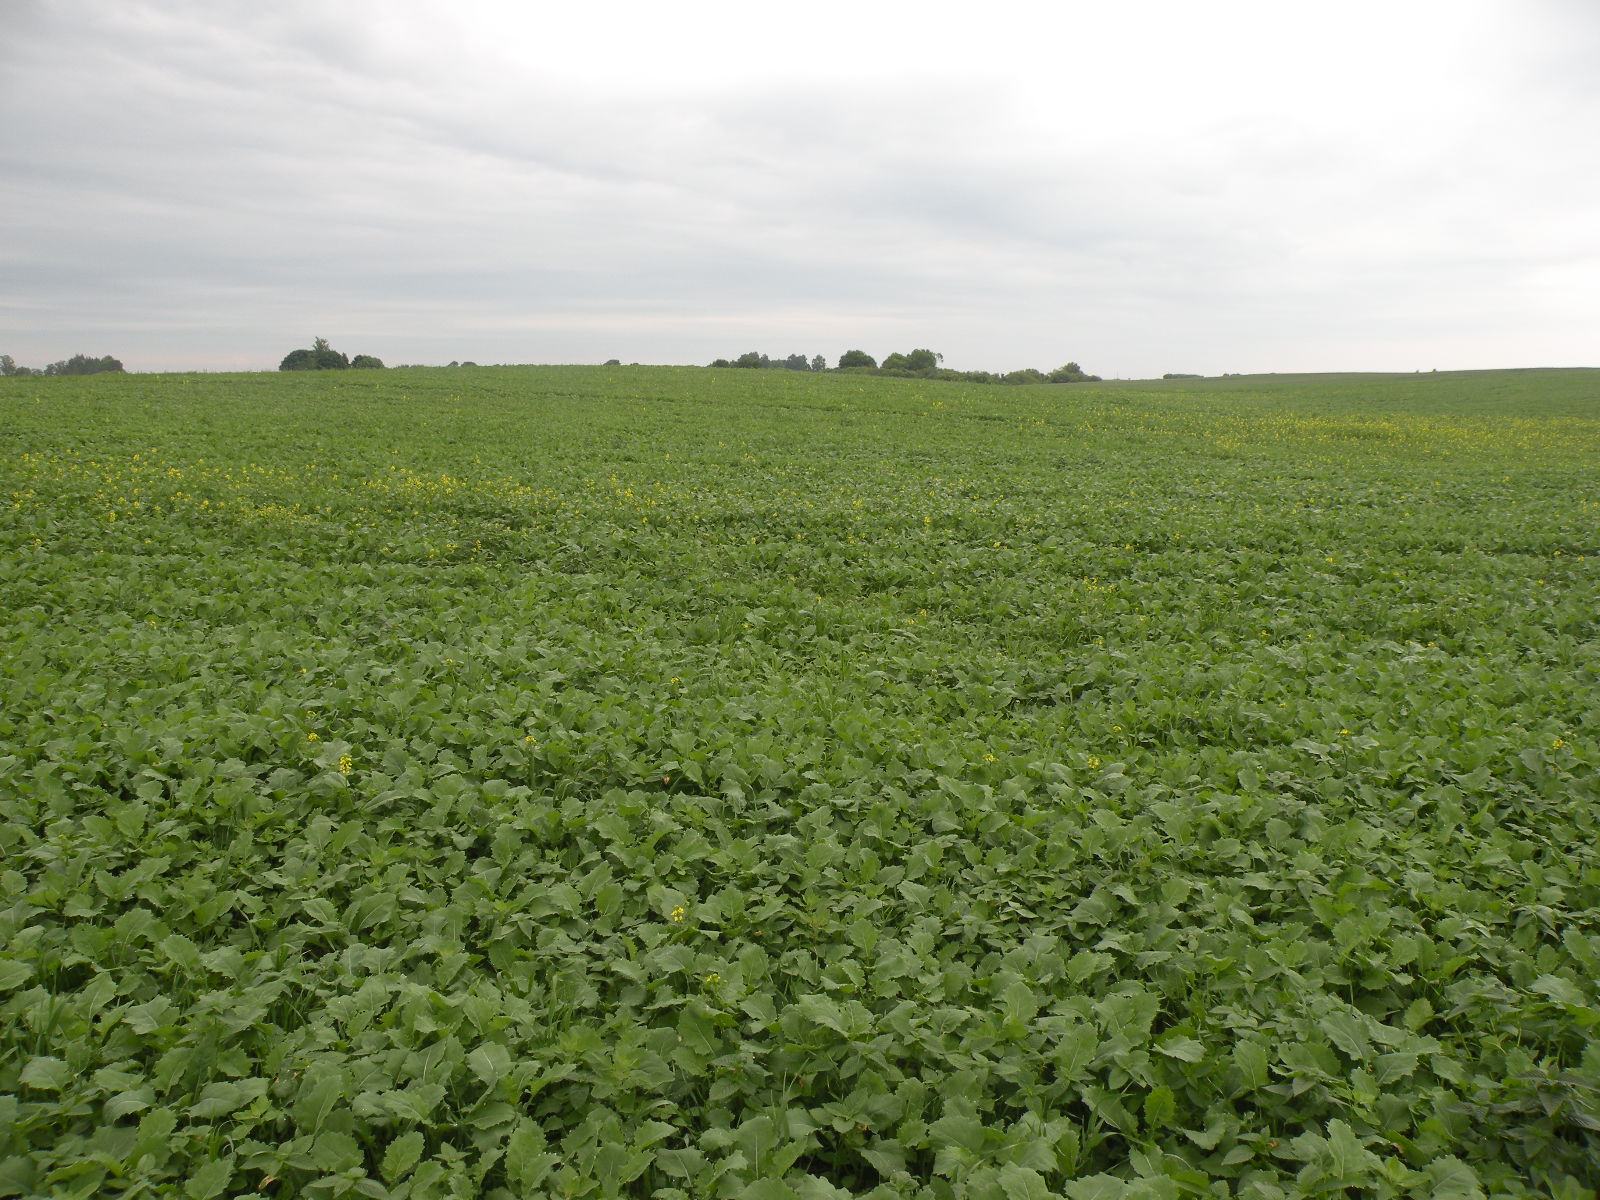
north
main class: Cropland
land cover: Rape and turnip rape
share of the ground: > 75 %
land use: Agriculture (excluding fallow land and kitchen gardens)
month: June
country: LV
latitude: 56.0084
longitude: 26.7905
